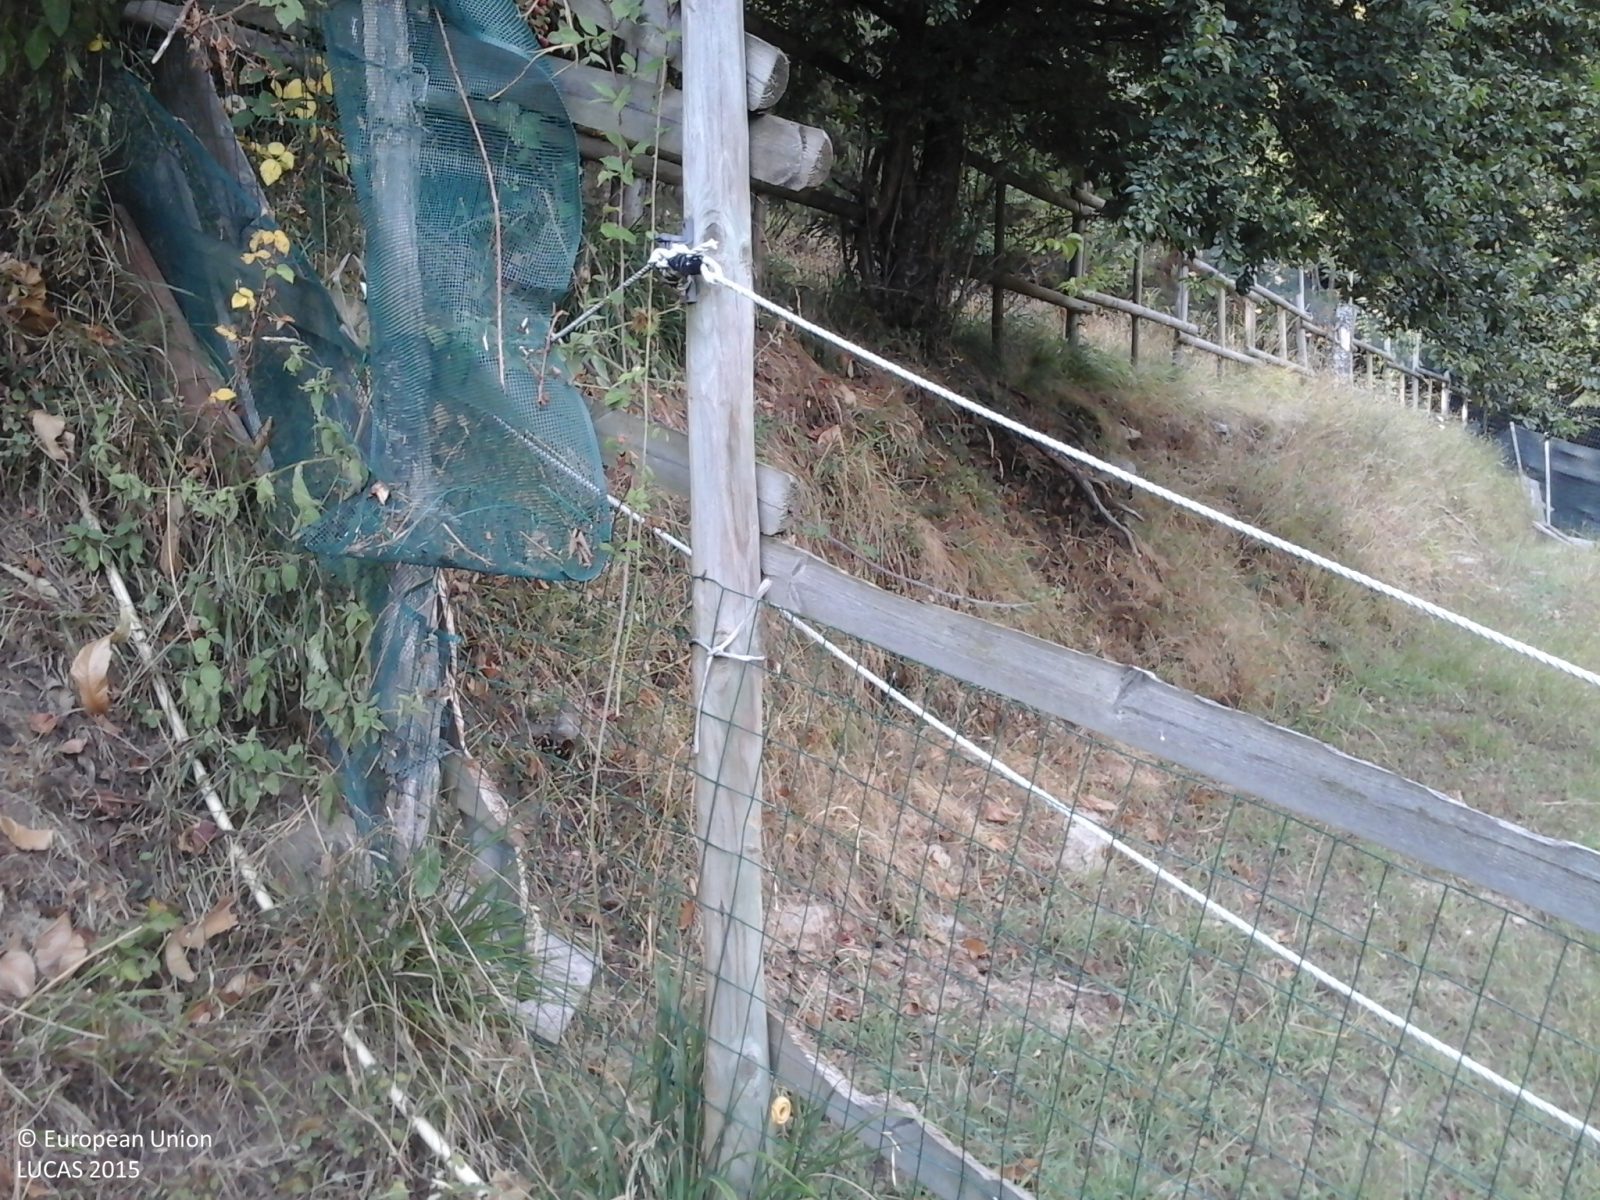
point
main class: Woodland
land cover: Broadleaved woodland
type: thermophilous deciduous forest
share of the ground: > 75 %
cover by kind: broadleaved forest trees 100 %
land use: Forestry
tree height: > 5 m
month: August
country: IT
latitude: 44.0255
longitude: 10.2862
